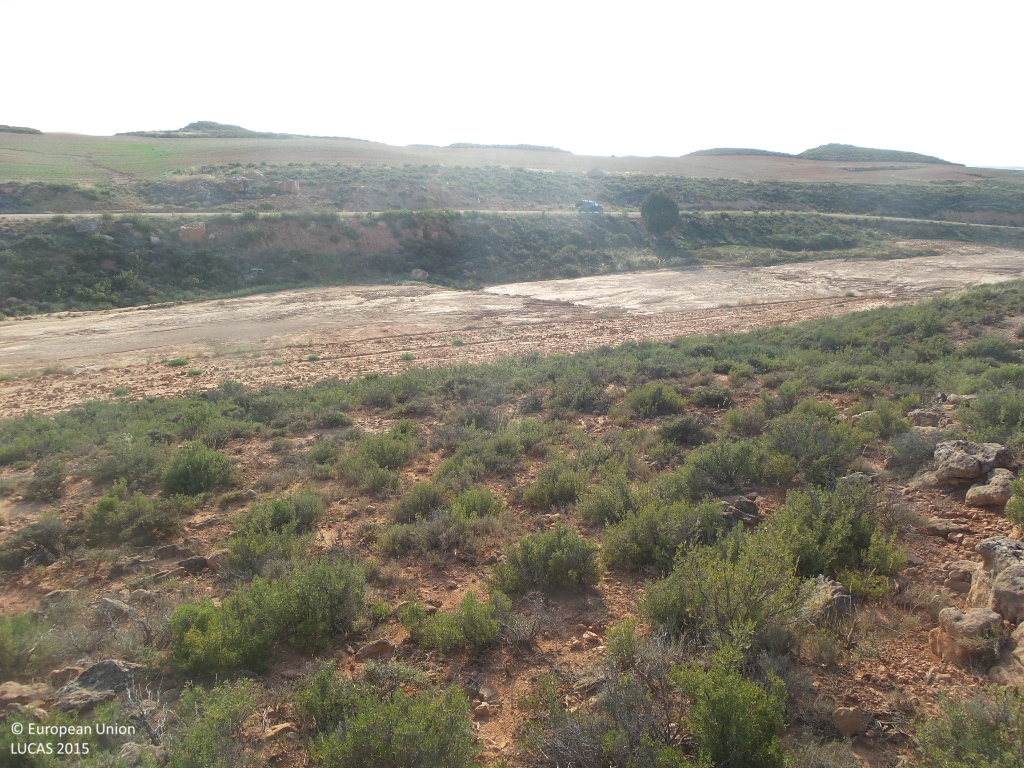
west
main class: Shrubland
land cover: Shrubland without tree cover
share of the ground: 25 - 50 %
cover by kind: shrubs 40 %, unconsolidated bare surface 30 %, consolidated bare surface 25 %, herbaceous plants 5 %
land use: Semi-natural and natural areas not in use
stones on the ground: < 10 %
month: July
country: ES
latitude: 41.2427
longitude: -2.1644
